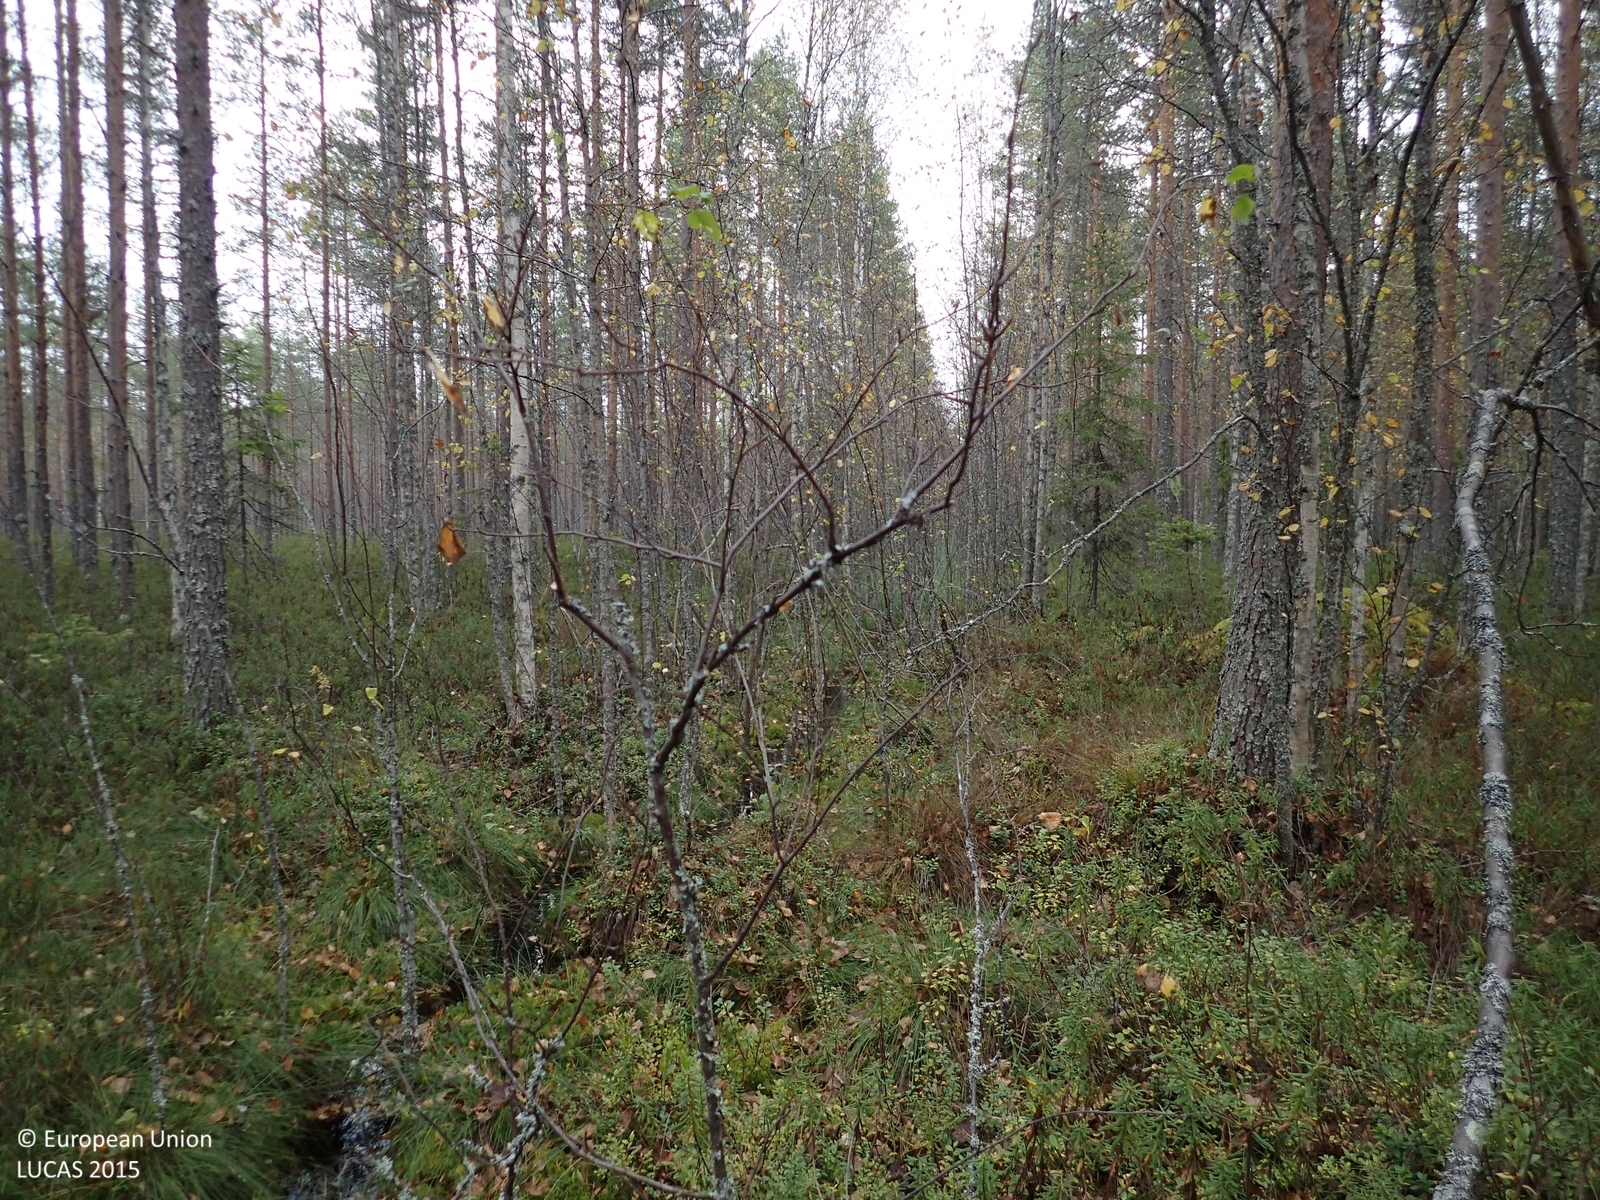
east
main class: Woodland
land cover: Pine dominated mixed woodland
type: mire and swamp forests
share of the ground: > 75 %
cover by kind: coniferous forest trees 55 %, shrubs 25 %, broadleaved forest trees 20 %
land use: Forestry
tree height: > 5 m
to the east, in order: Pine dominated mixed woodland; Ditches and canals; Pine dominated mixed woodland; Pine dominated coniferous woodland; Ditches and canals; Pine dominated coniferous woodland; Pine dominated mixed woodland; Ditches and canals; Pine dominated mixed woodland
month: September
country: FI
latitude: 63.3225
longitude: 25.2503
